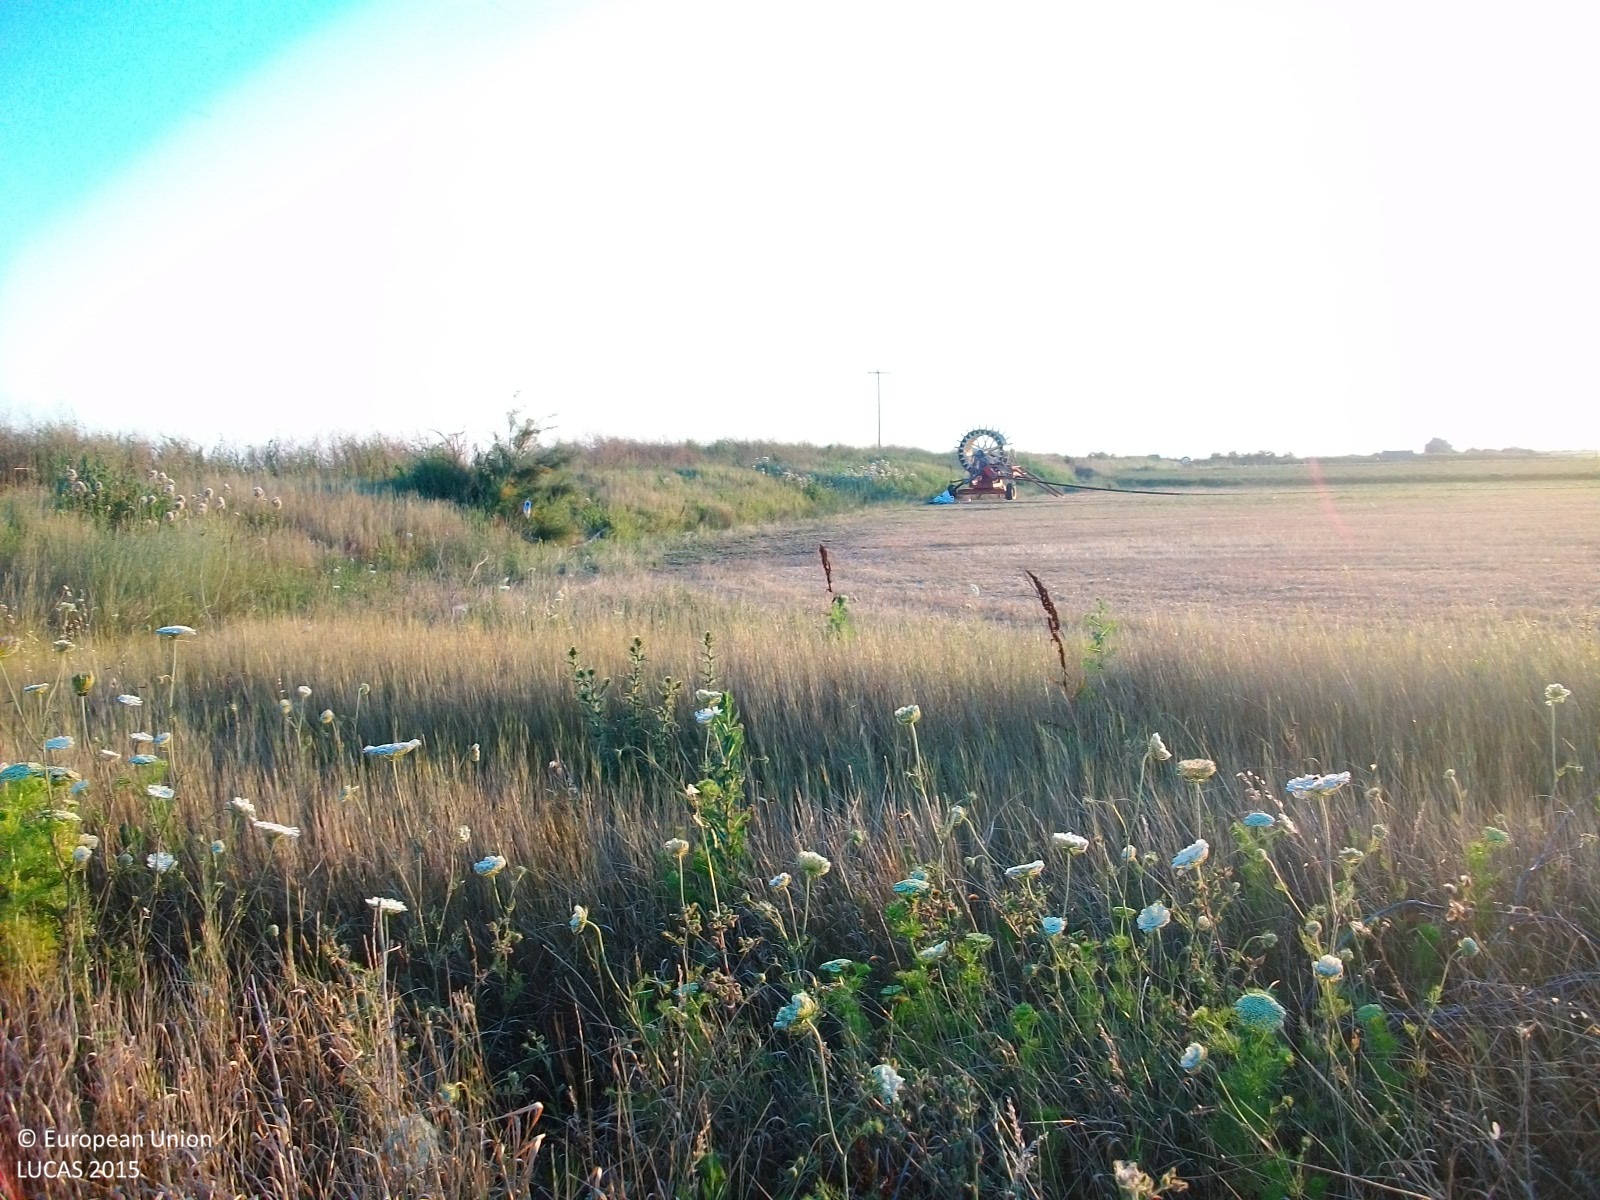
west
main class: Grassland
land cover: Spontaneously vegetated surfaces
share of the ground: > 75 %
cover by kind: herbaceous plants 100 %
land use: Fallow land
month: July
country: GR
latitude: 40.8264
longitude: 26.0793
